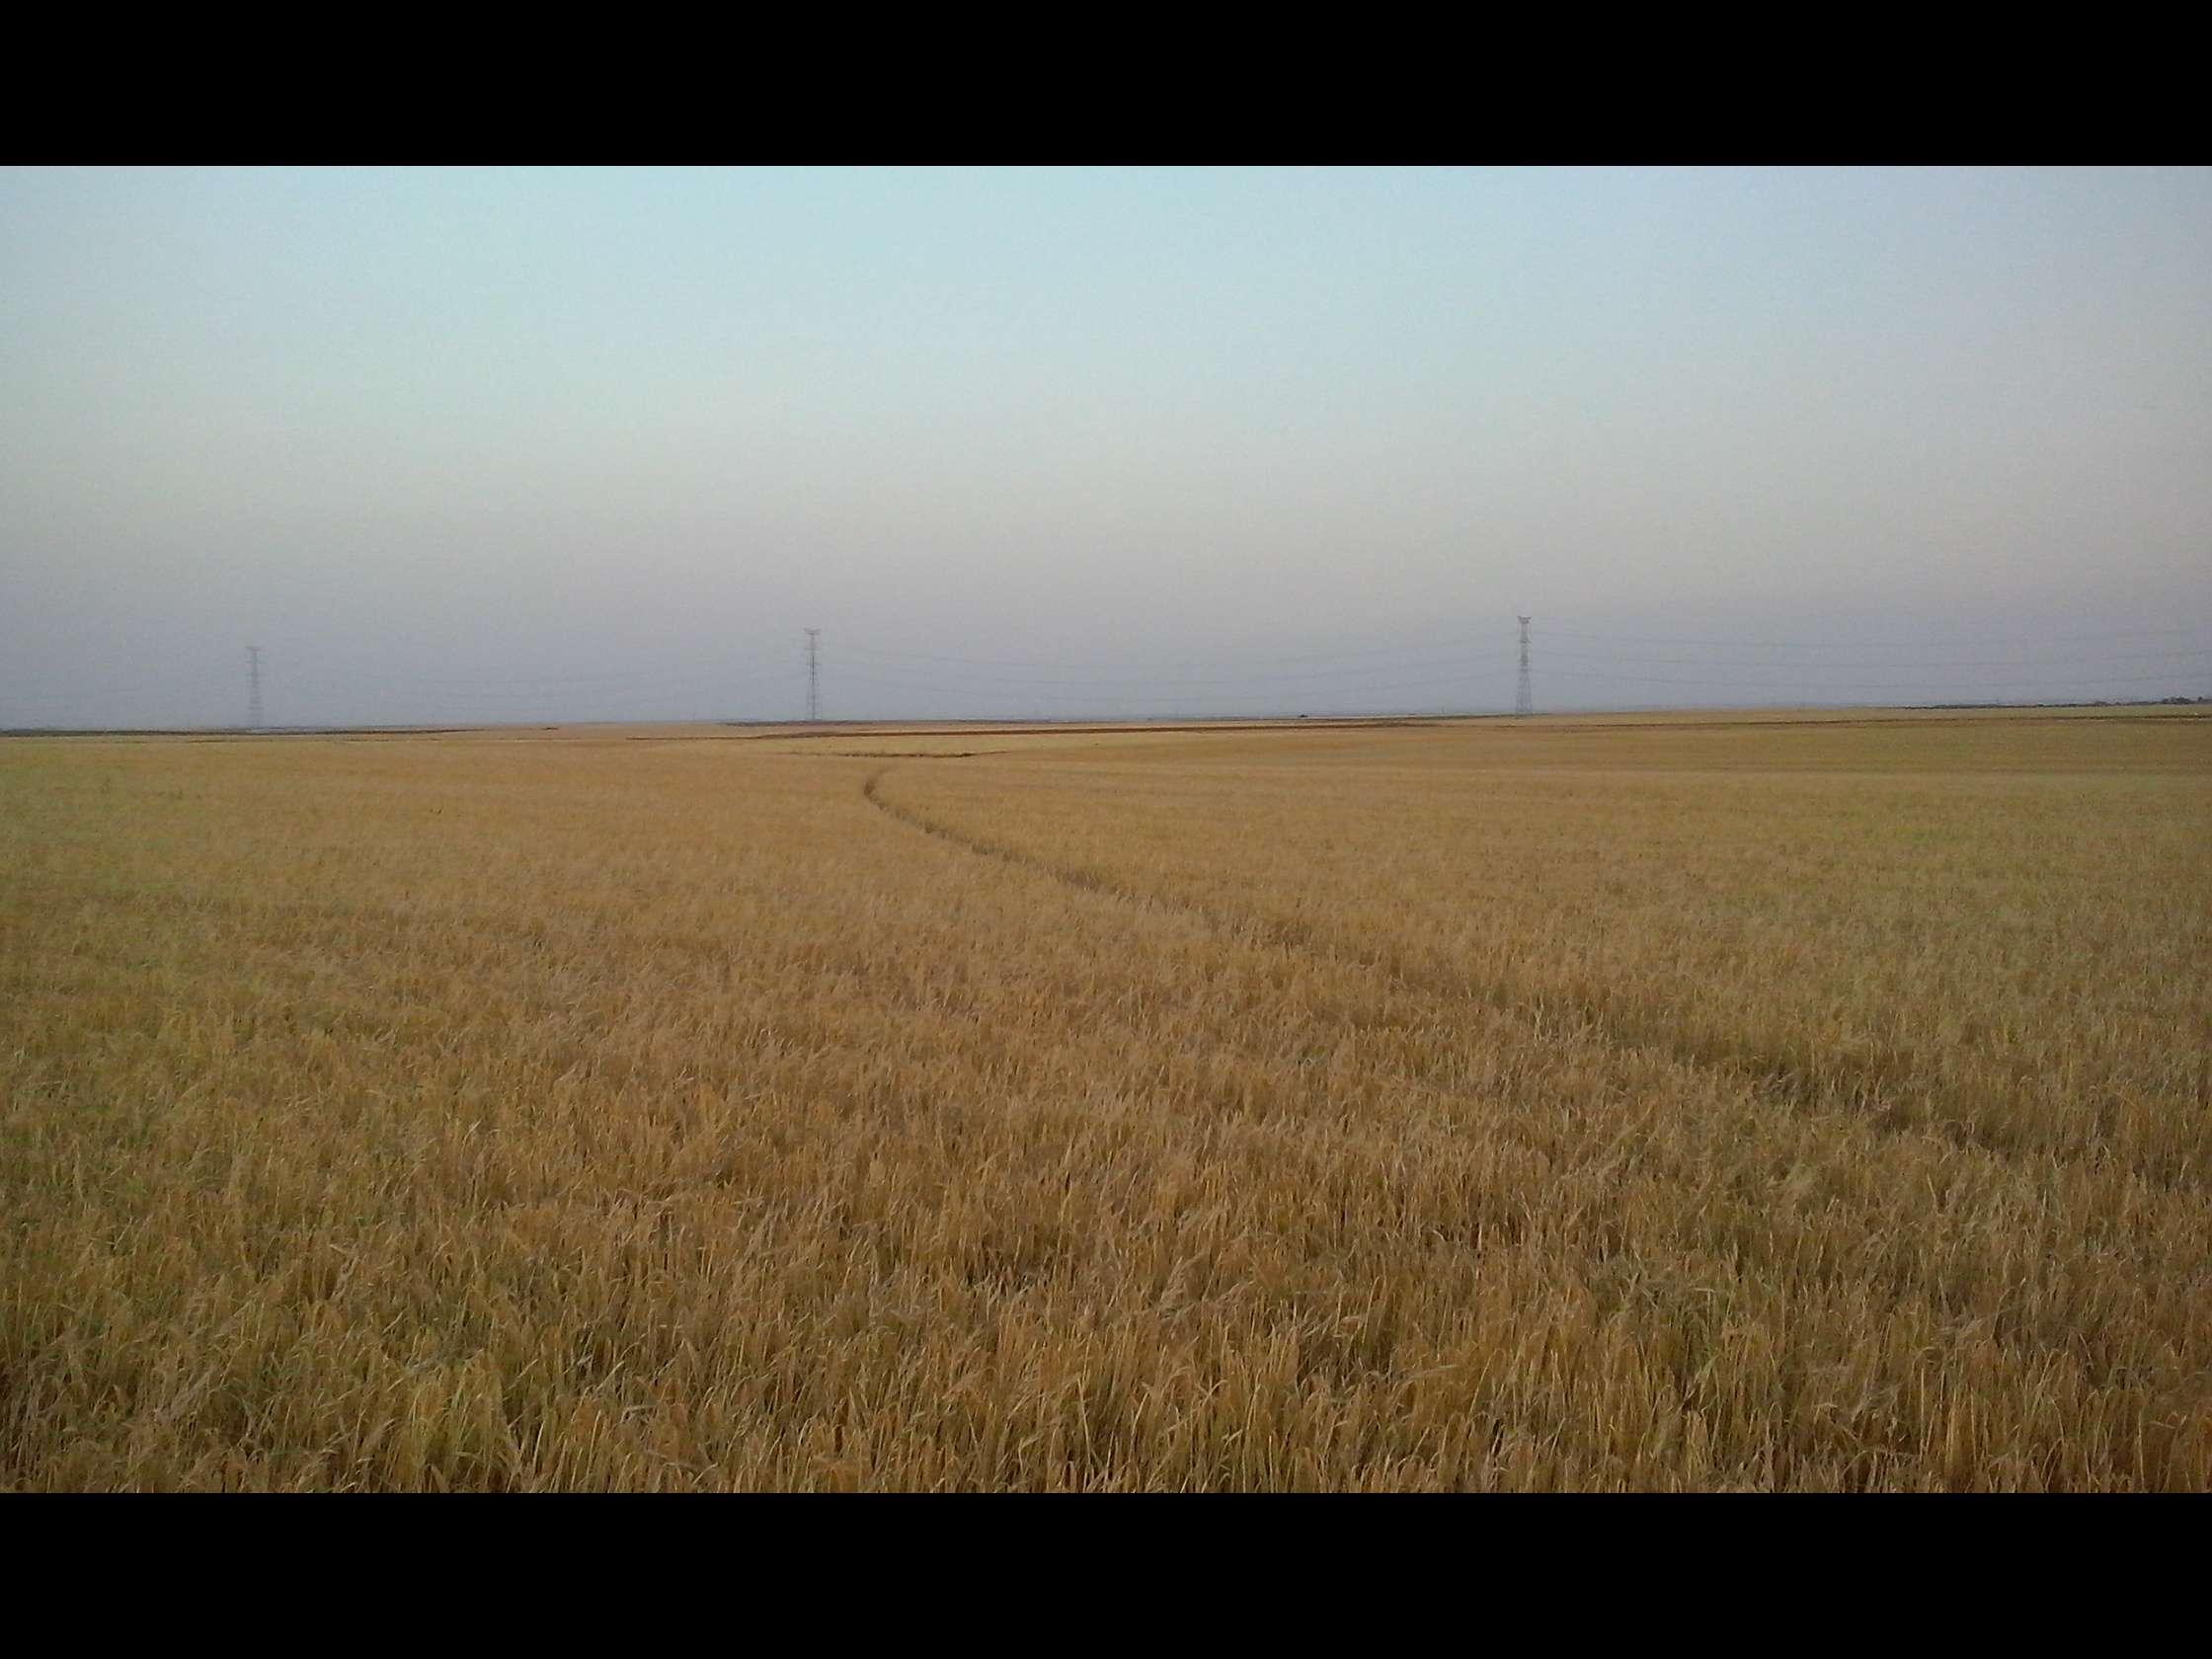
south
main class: Cropland
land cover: Barley
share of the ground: > 75 %
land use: Agriculture (excluding fallow land and kitchen gardens)
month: June
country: ES
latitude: 41.6073
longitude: -5.3308
